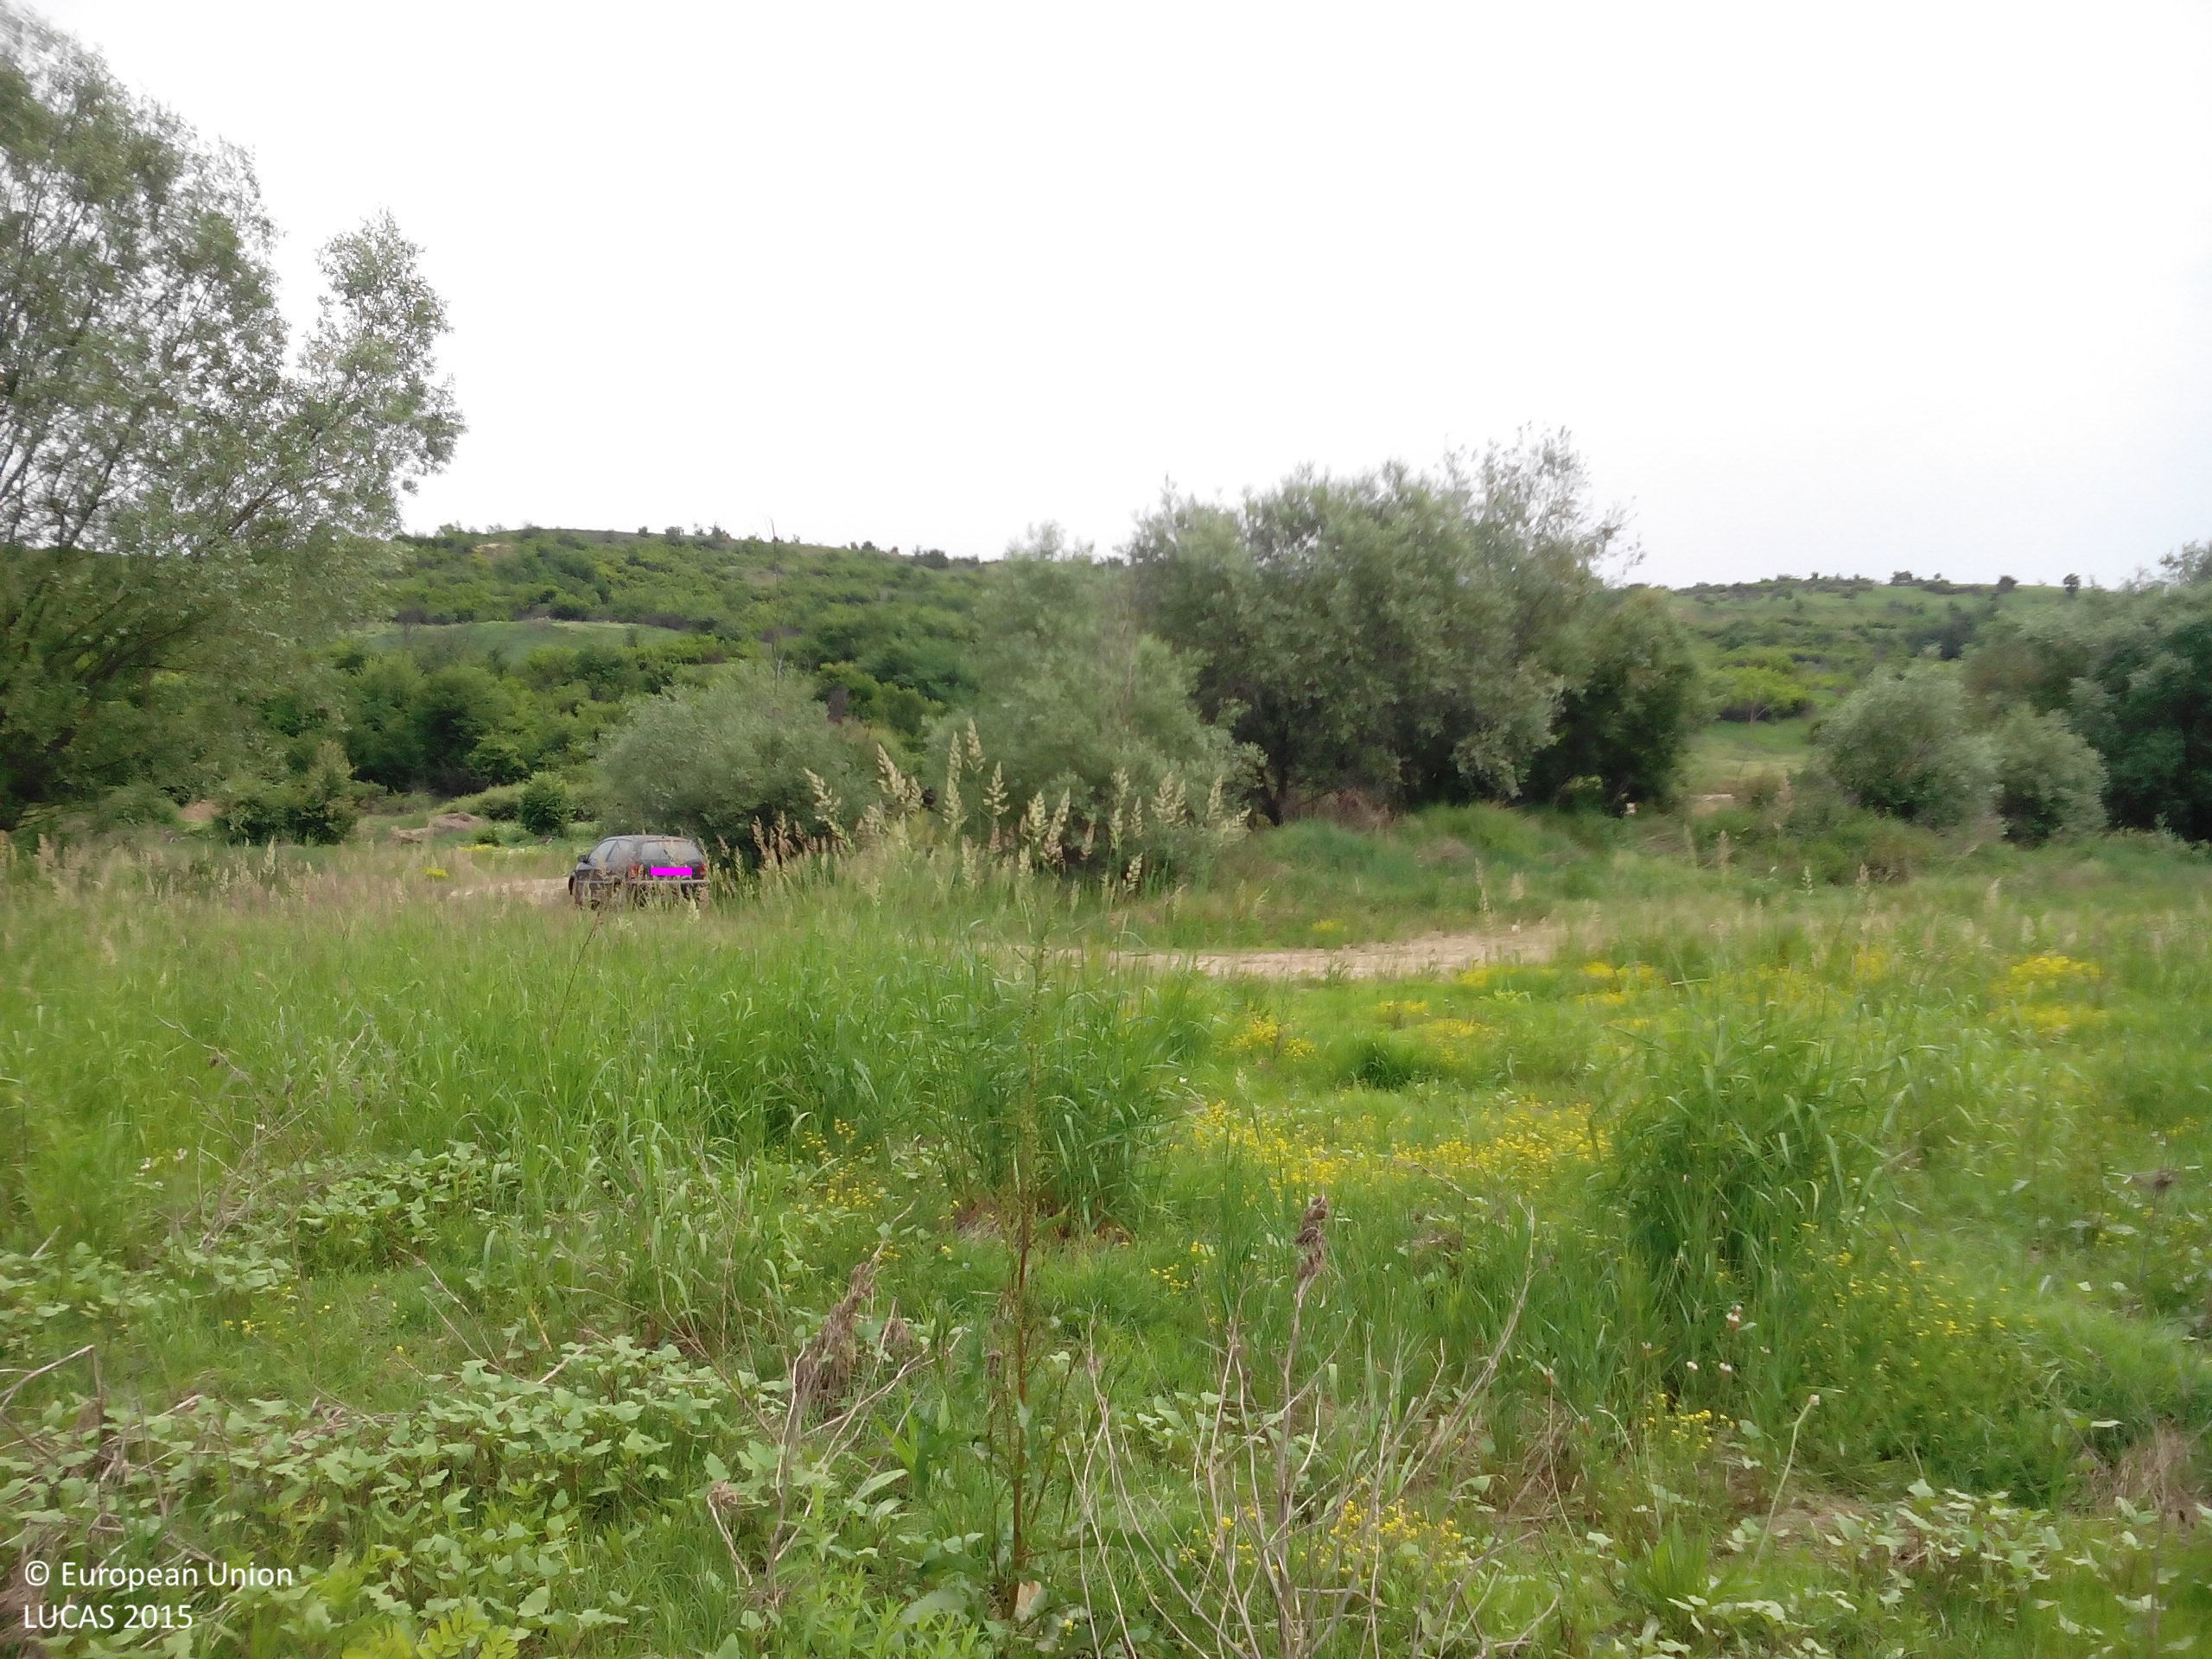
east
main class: Grassland
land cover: Grassland without tree/shrub cover
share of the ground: > 75 %
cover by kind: herbaceous plants 95 %, shrubs 5 %
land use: Agriculture (excluding fallow land and kitchen gardens)
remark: Temporary dry
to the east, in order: Grassland without tree/shrub cover; Tracks; Broadleaved woodland; Grassland without tree/shrub cover; Tracks; Shrubland with sparse tree cover; Broadleaved woodland; Tracks; Broadleaved woodland; Tracks; Broadleaved woodland; Grassland with sparse tree/shrub cover
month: May
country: BG
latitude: 43.4907
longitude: 24.2402
